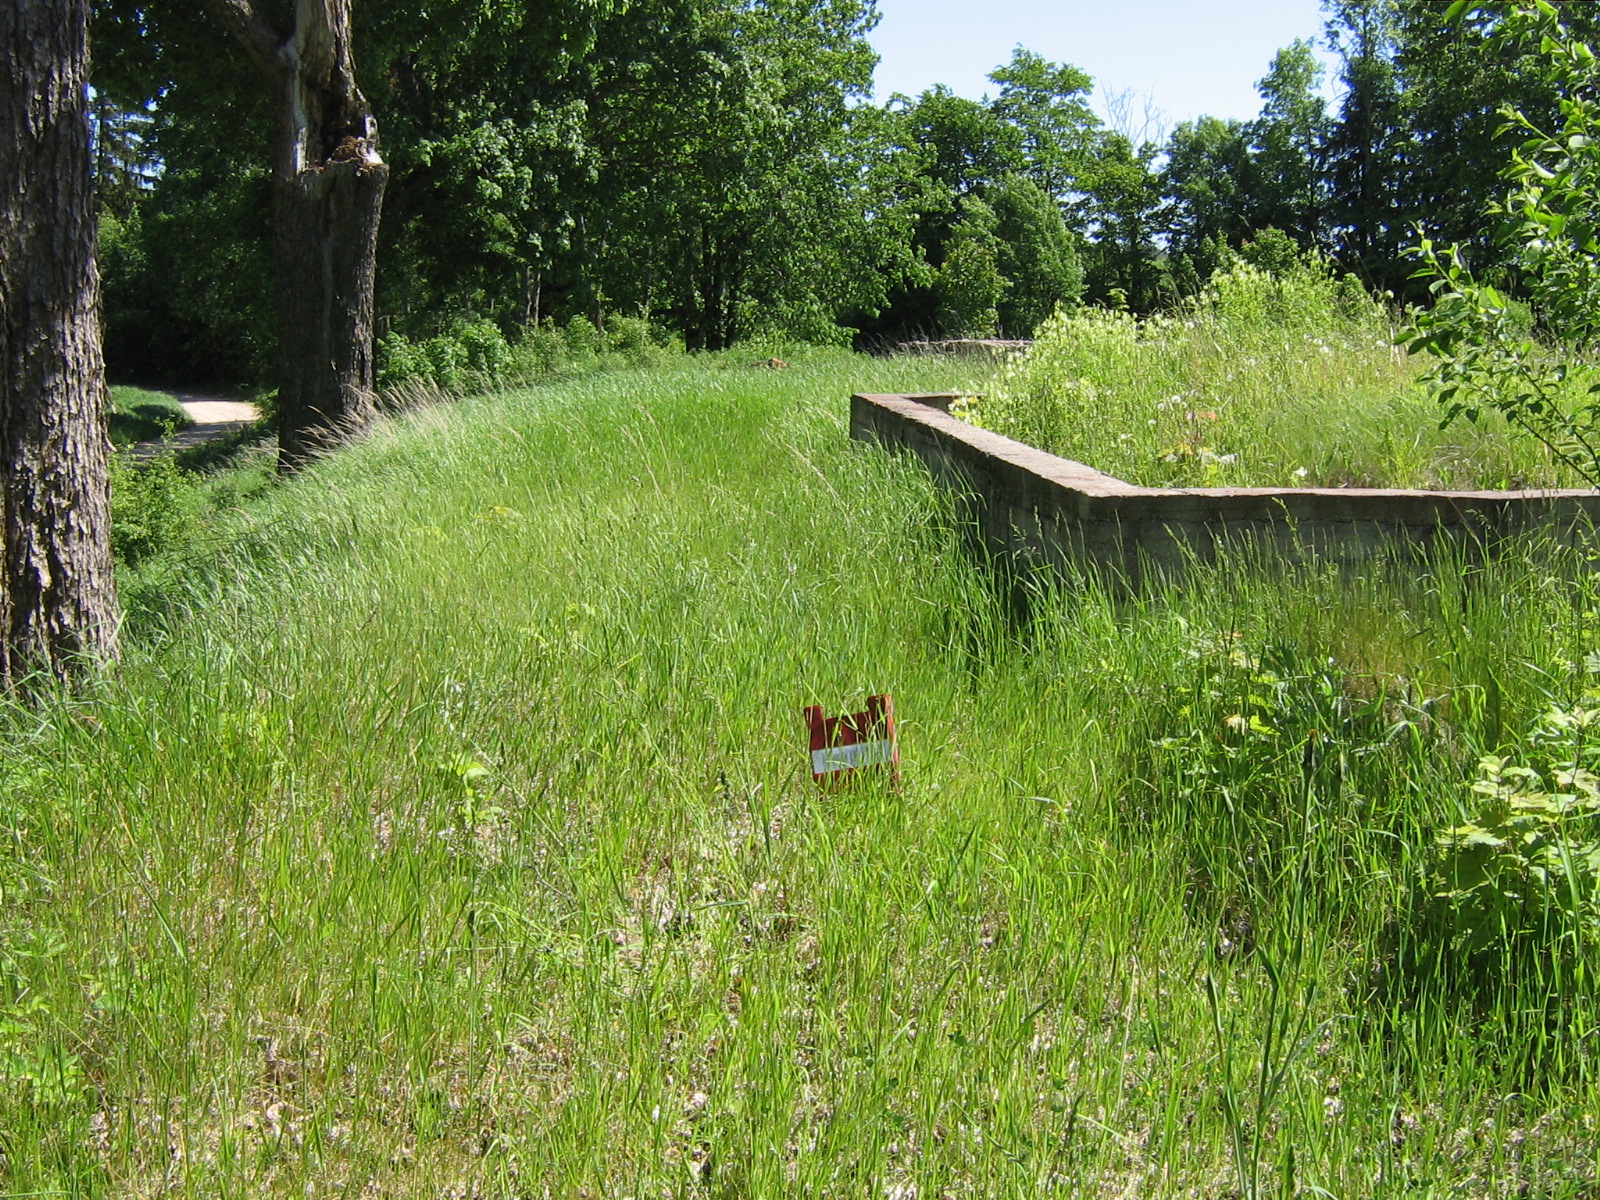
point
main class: Grassland
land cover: Spontaneously vegetated surfaces
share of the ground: > 75 %
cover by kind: herbaceous plants 95 %, shrubs 5 %
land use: Abandoned areas
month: June
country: LV
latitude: 57.1070
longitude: 25.8269
